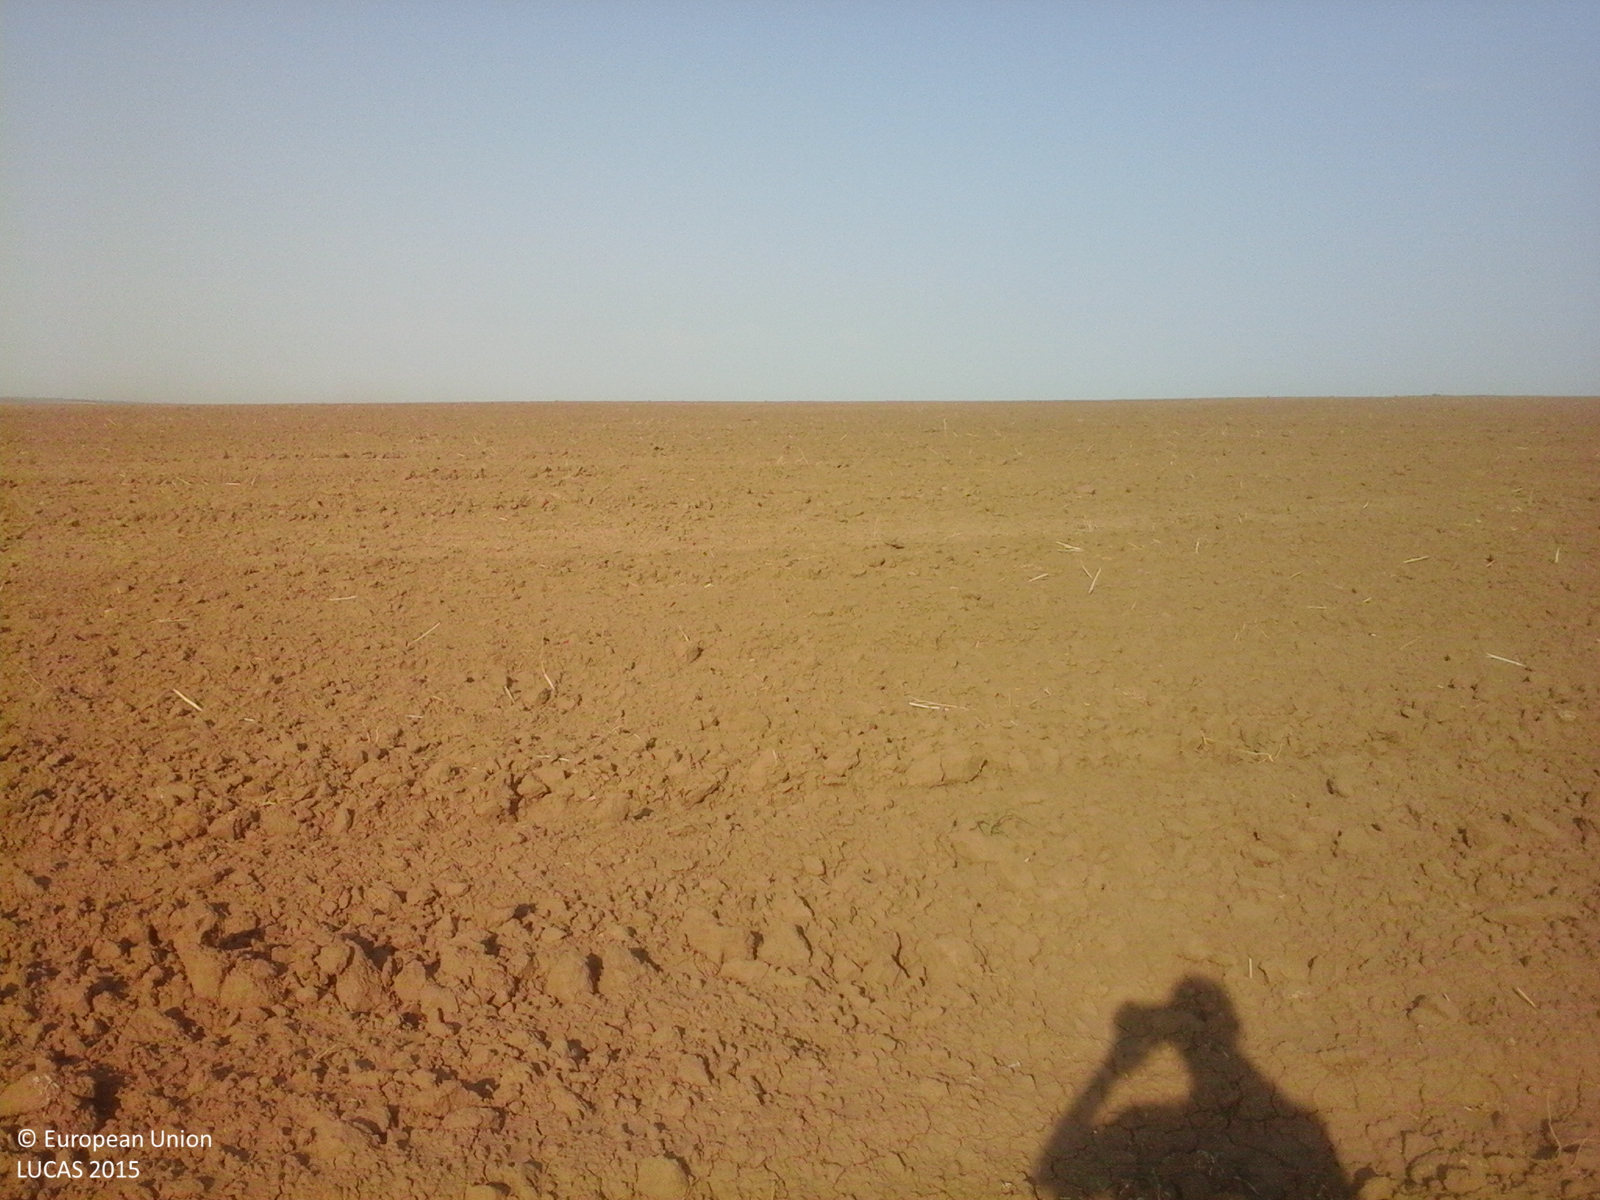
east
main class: Cropland
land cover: Rape and turnip rape
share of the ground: < 10 %
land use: Agriculture (excluding fallow land and kitchen gardens)
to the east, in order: Rape and turnip rape
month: August
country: RO
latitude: 43.9796
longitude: 28.0940
